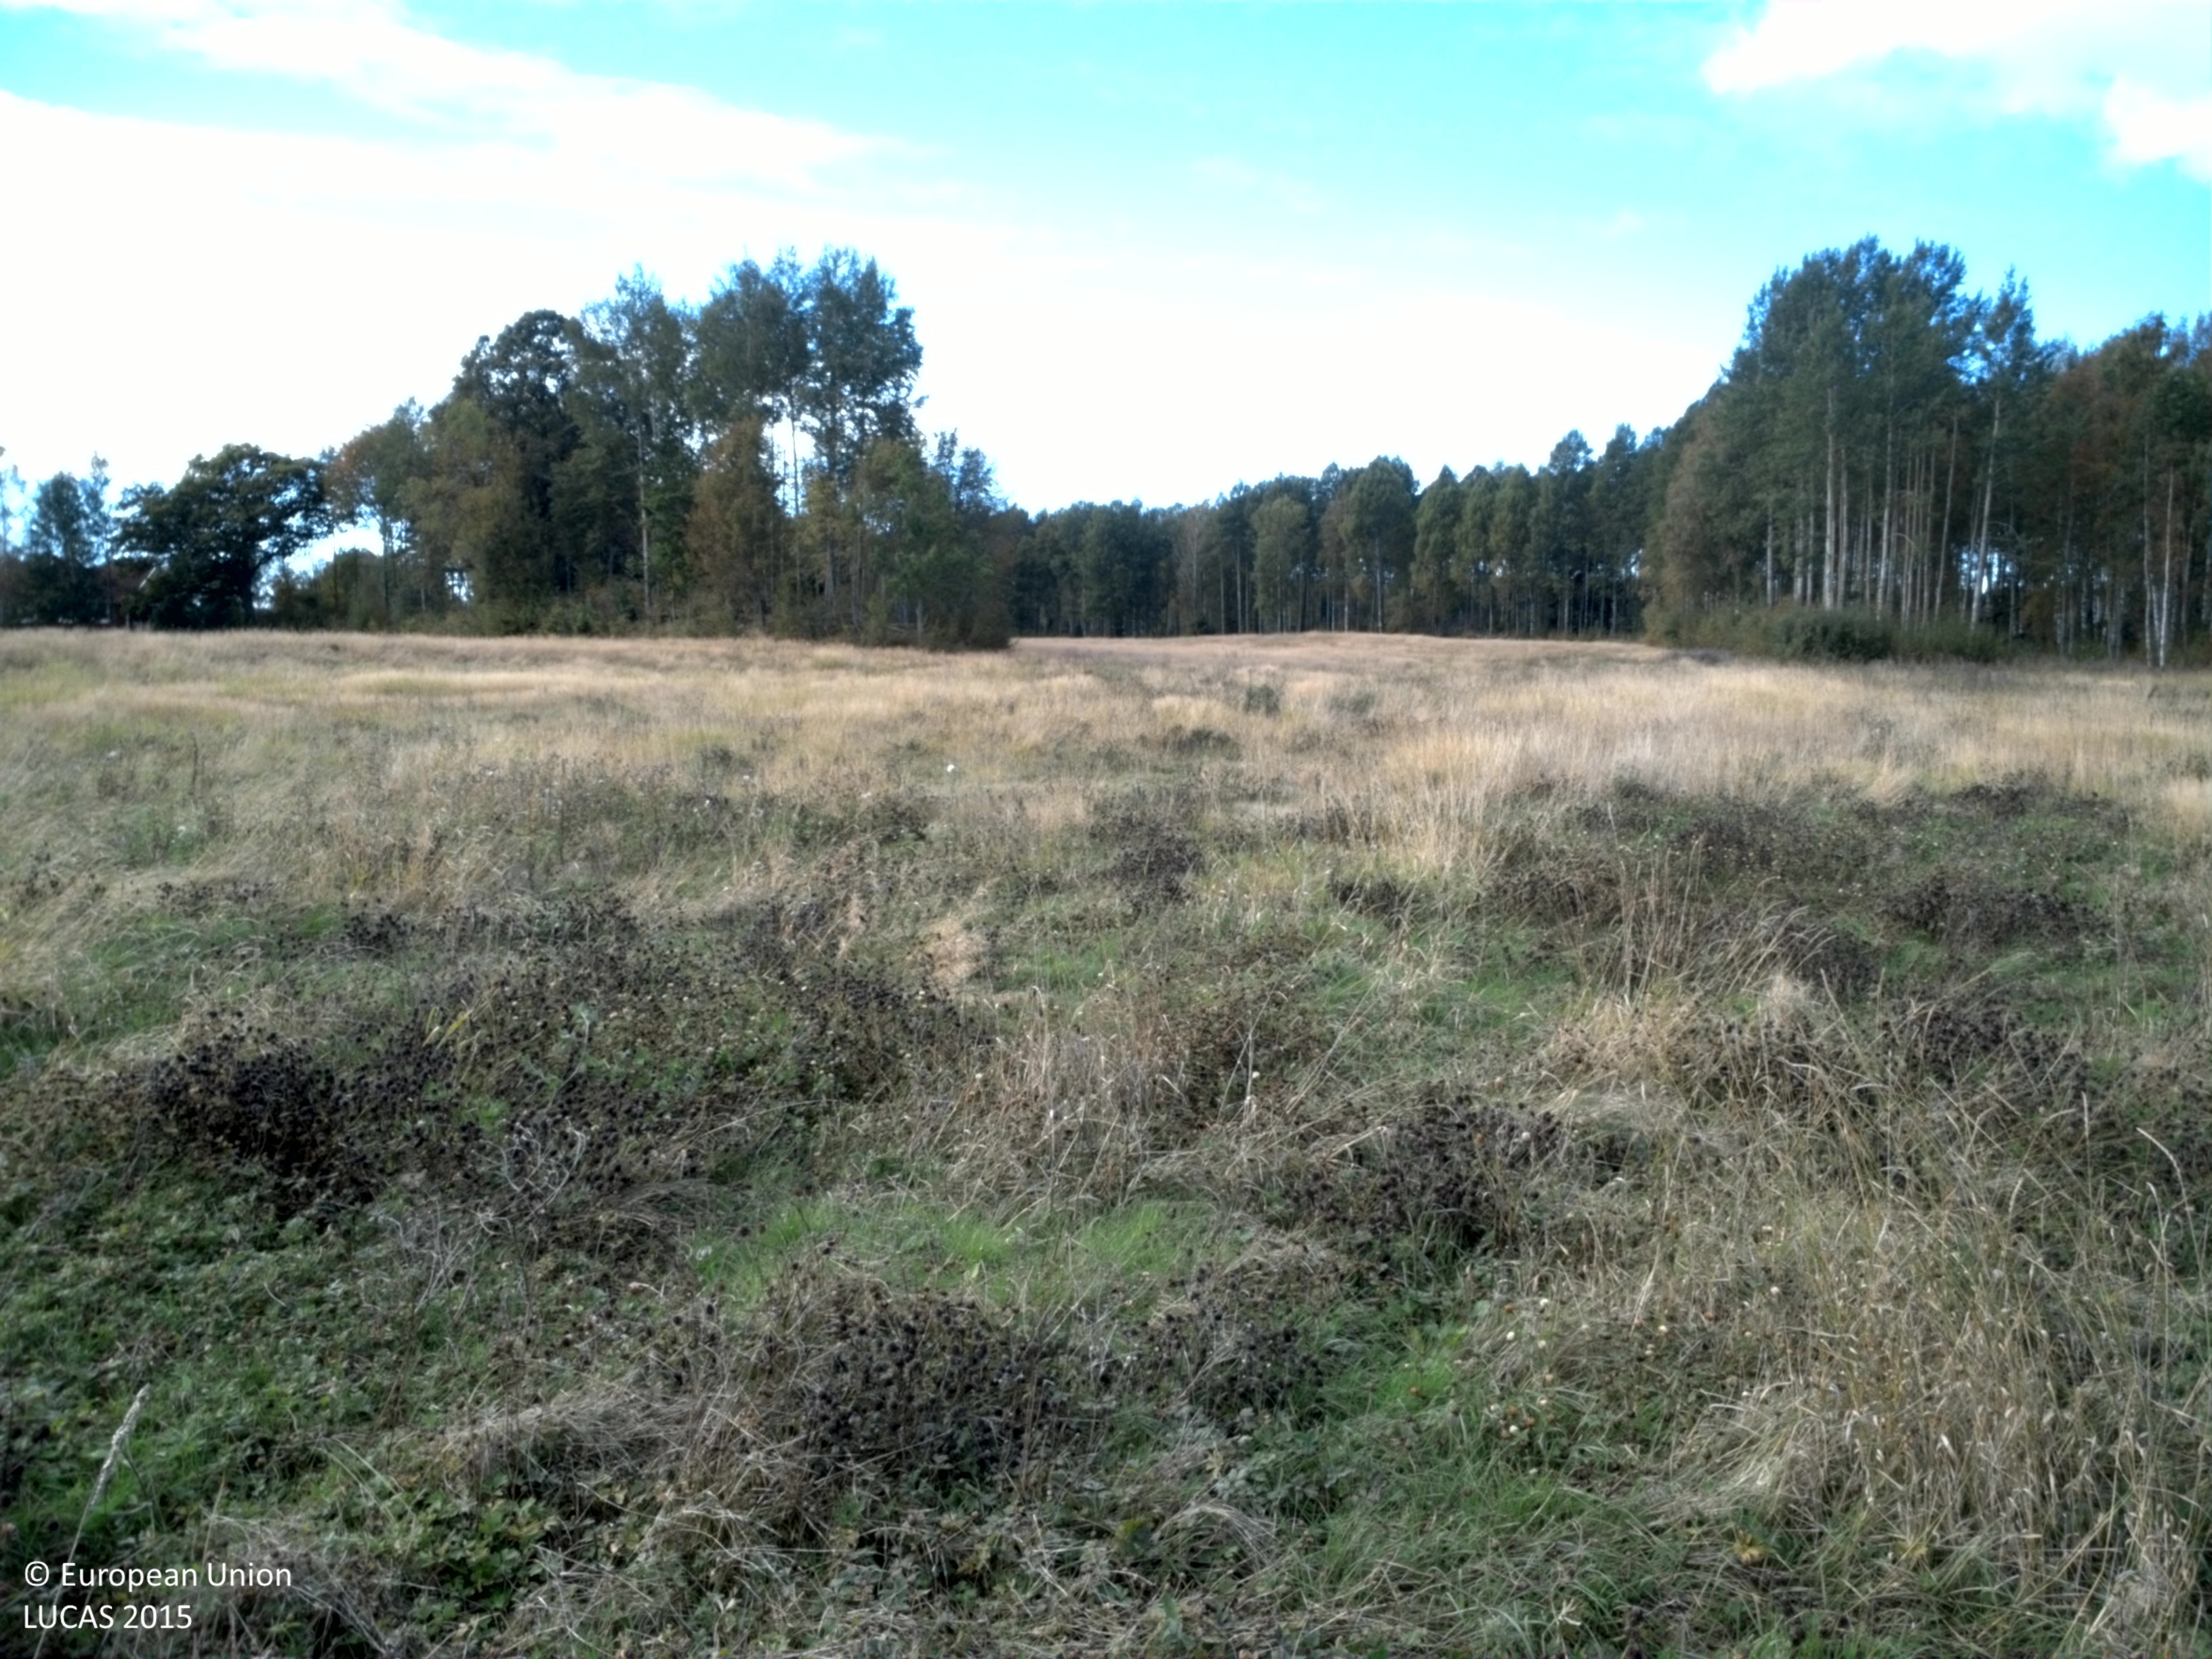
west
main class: Grassland
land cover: Spontaneously vegetated surfaces
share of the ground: > 75 %
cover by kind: herbaceous plants 100 %
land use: Fallow land
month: September
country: SE
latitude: 59.0929
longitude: 14.1289
